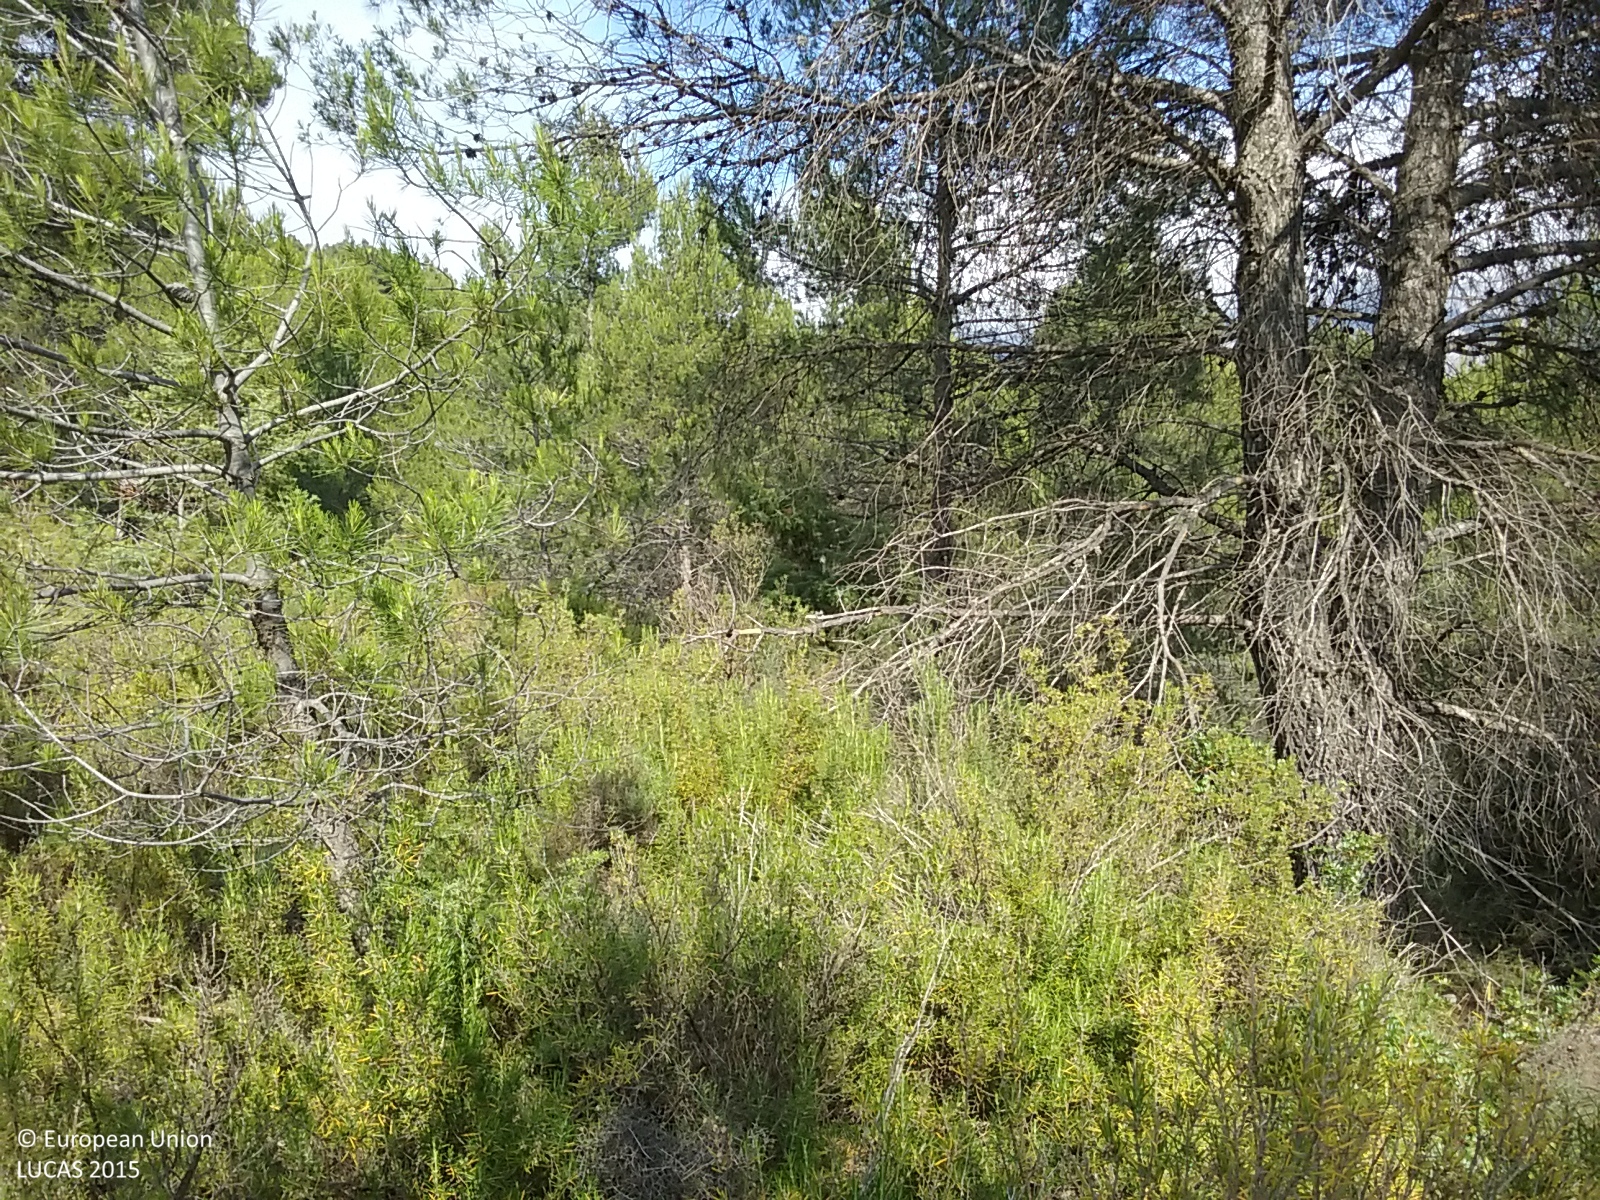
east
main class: Woodland
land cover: Pine dominated coniferous woodland
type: coniferous forest of the mediterranean region
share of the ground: 50 - 75 %
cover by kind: coniferous forest trees 70 %, shrubs 25 %, unconsolidated bare surface 5 %
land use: Semi-natural and natural areas not in use
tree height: > 5 m
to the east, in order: Pine dominated coniferous woodland; Dry stone walls; Pine dominated coniferous woodland; Dry stone walls; Pine dominated coniferous woodland
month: June
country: ES
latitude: 40.9540
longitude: 0.3332
